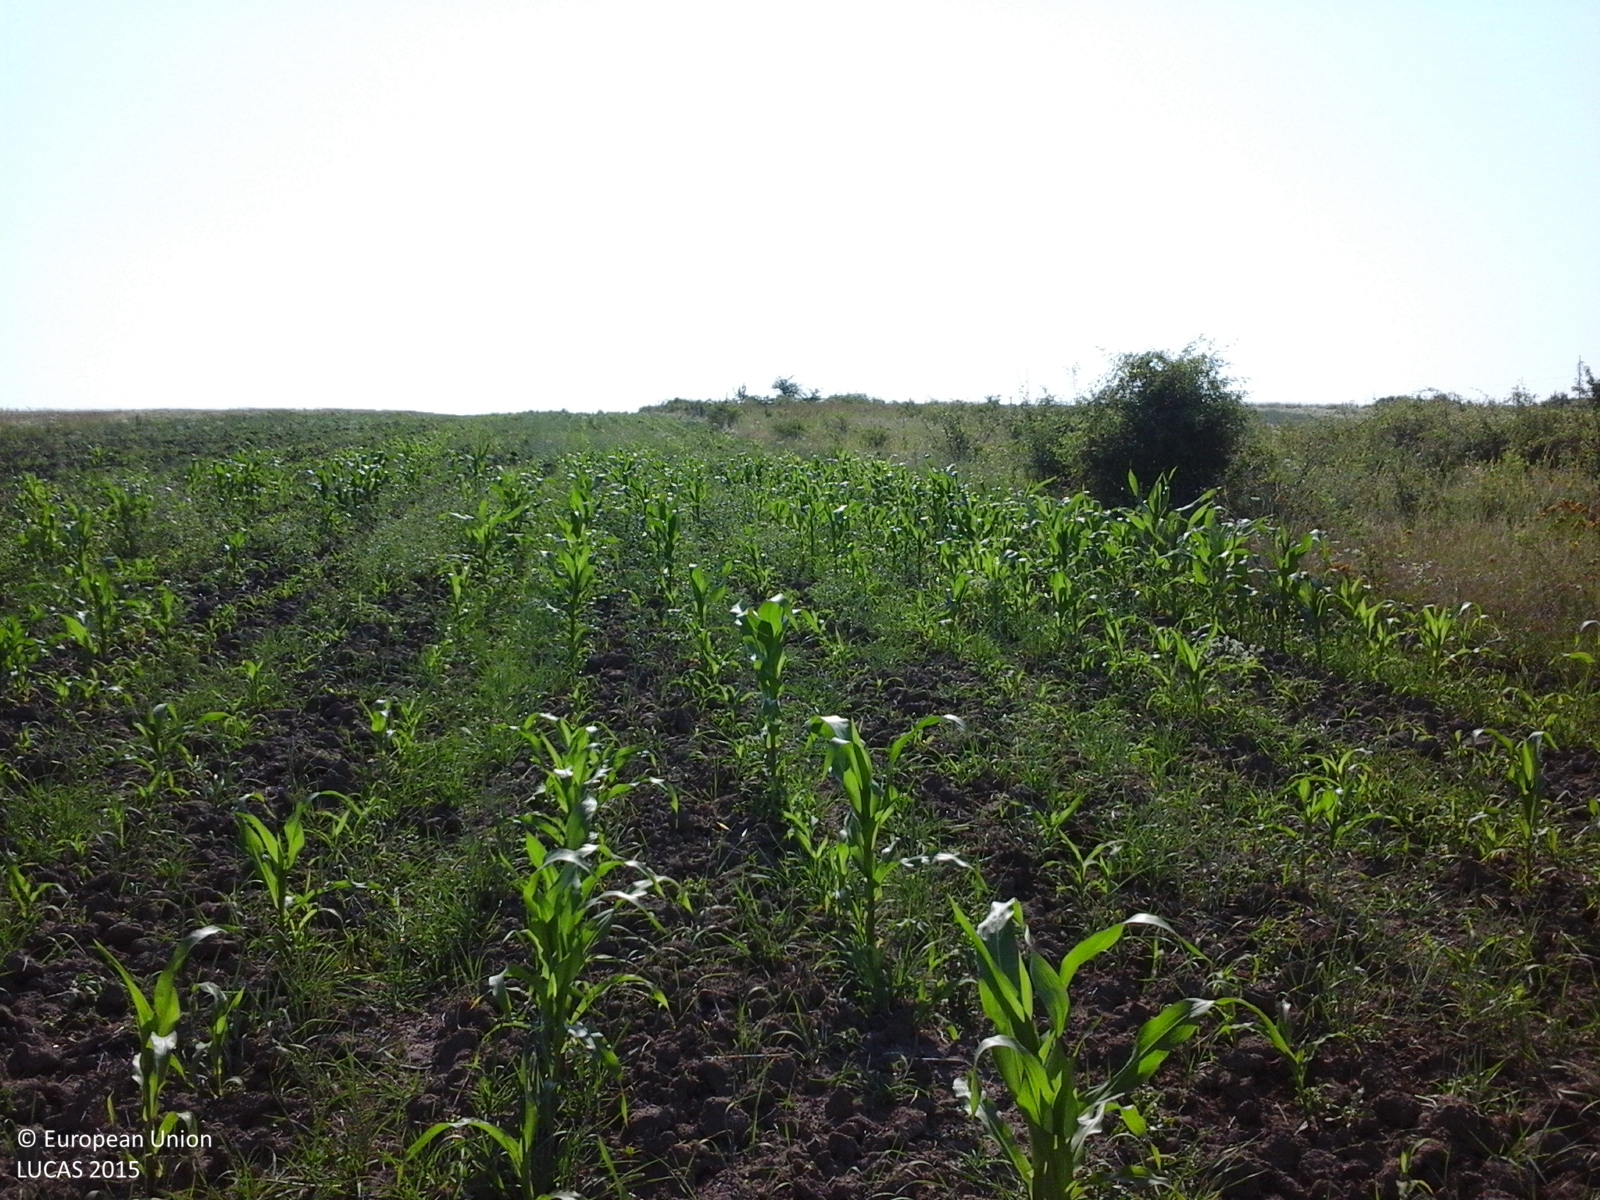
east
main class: Cropland
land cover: Maize
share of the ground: < 10 %
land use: Agriculture (excluding fallow land and kitchen gardens)
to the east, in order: Maize; Shrubland with sparse tree cover
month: July
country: RO
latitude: 44.6105
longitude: 24.6028
